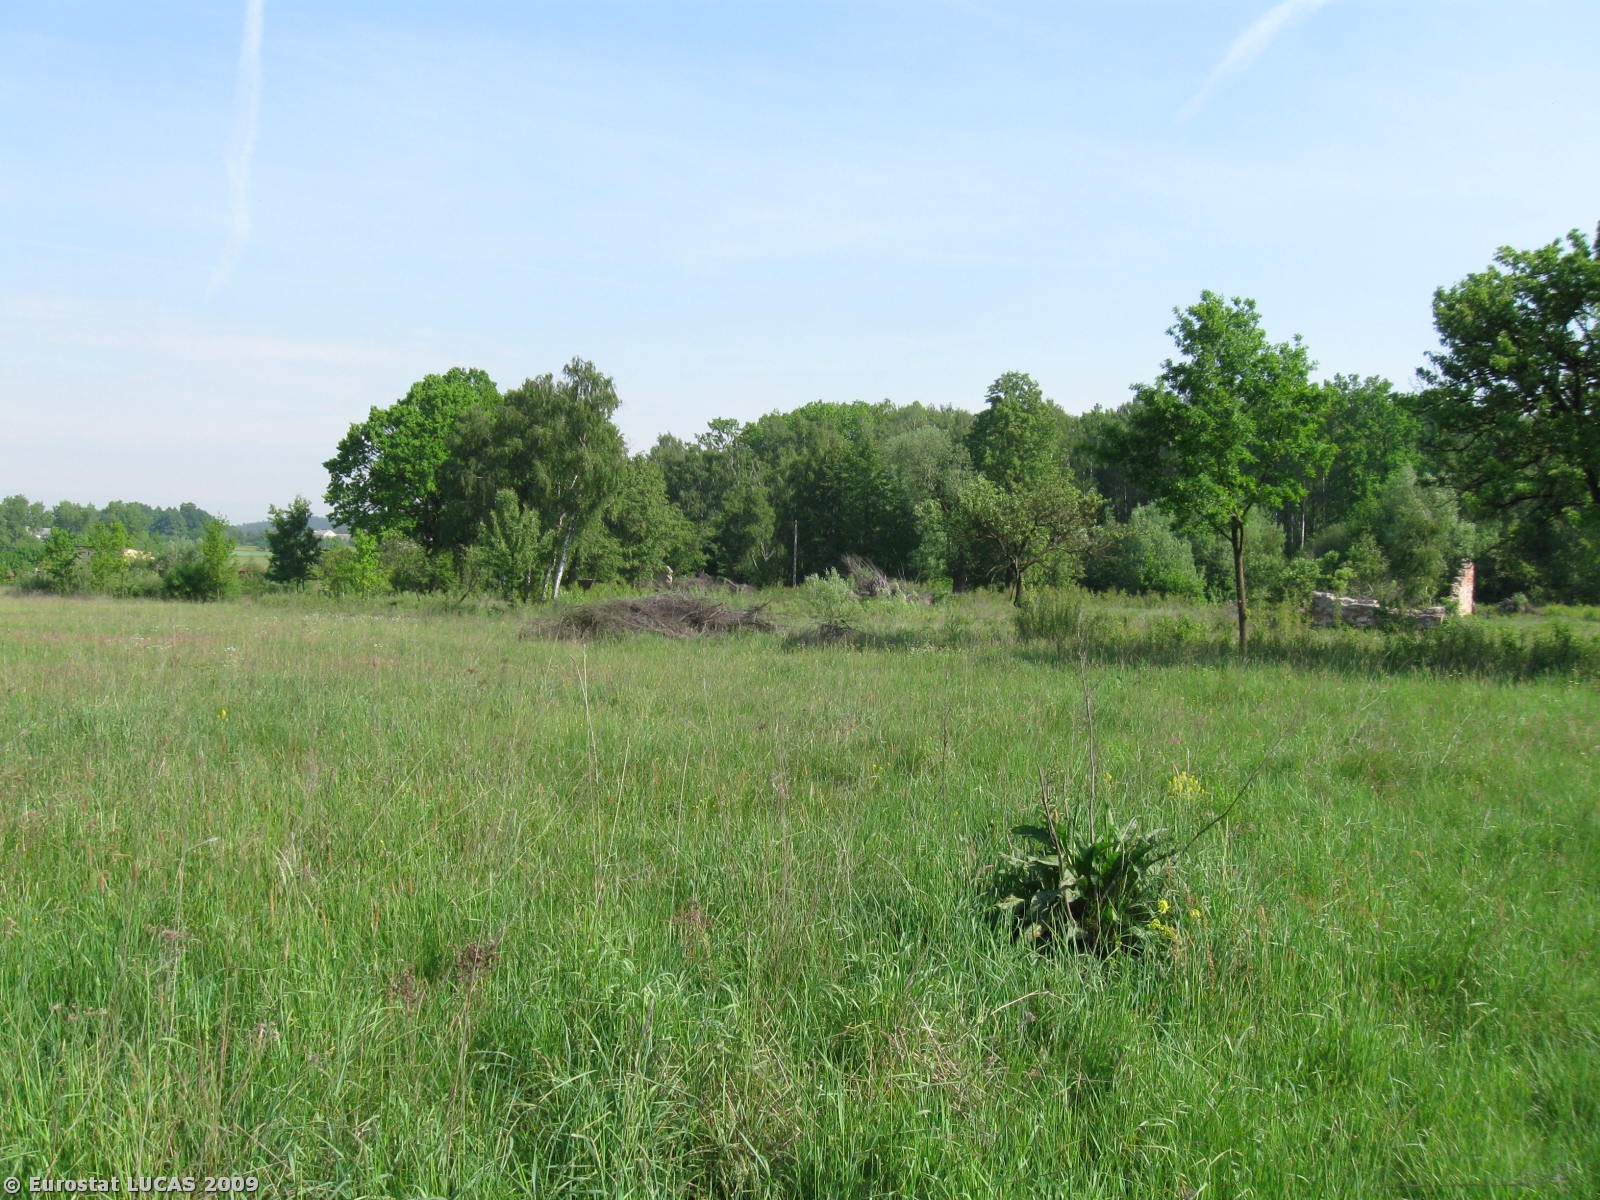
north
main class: Grassland
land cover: Grassland without tree/shrub cover
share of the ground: > 75 %
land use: Unused
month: May
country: PL
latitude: 50.8098
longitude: 20.4400
